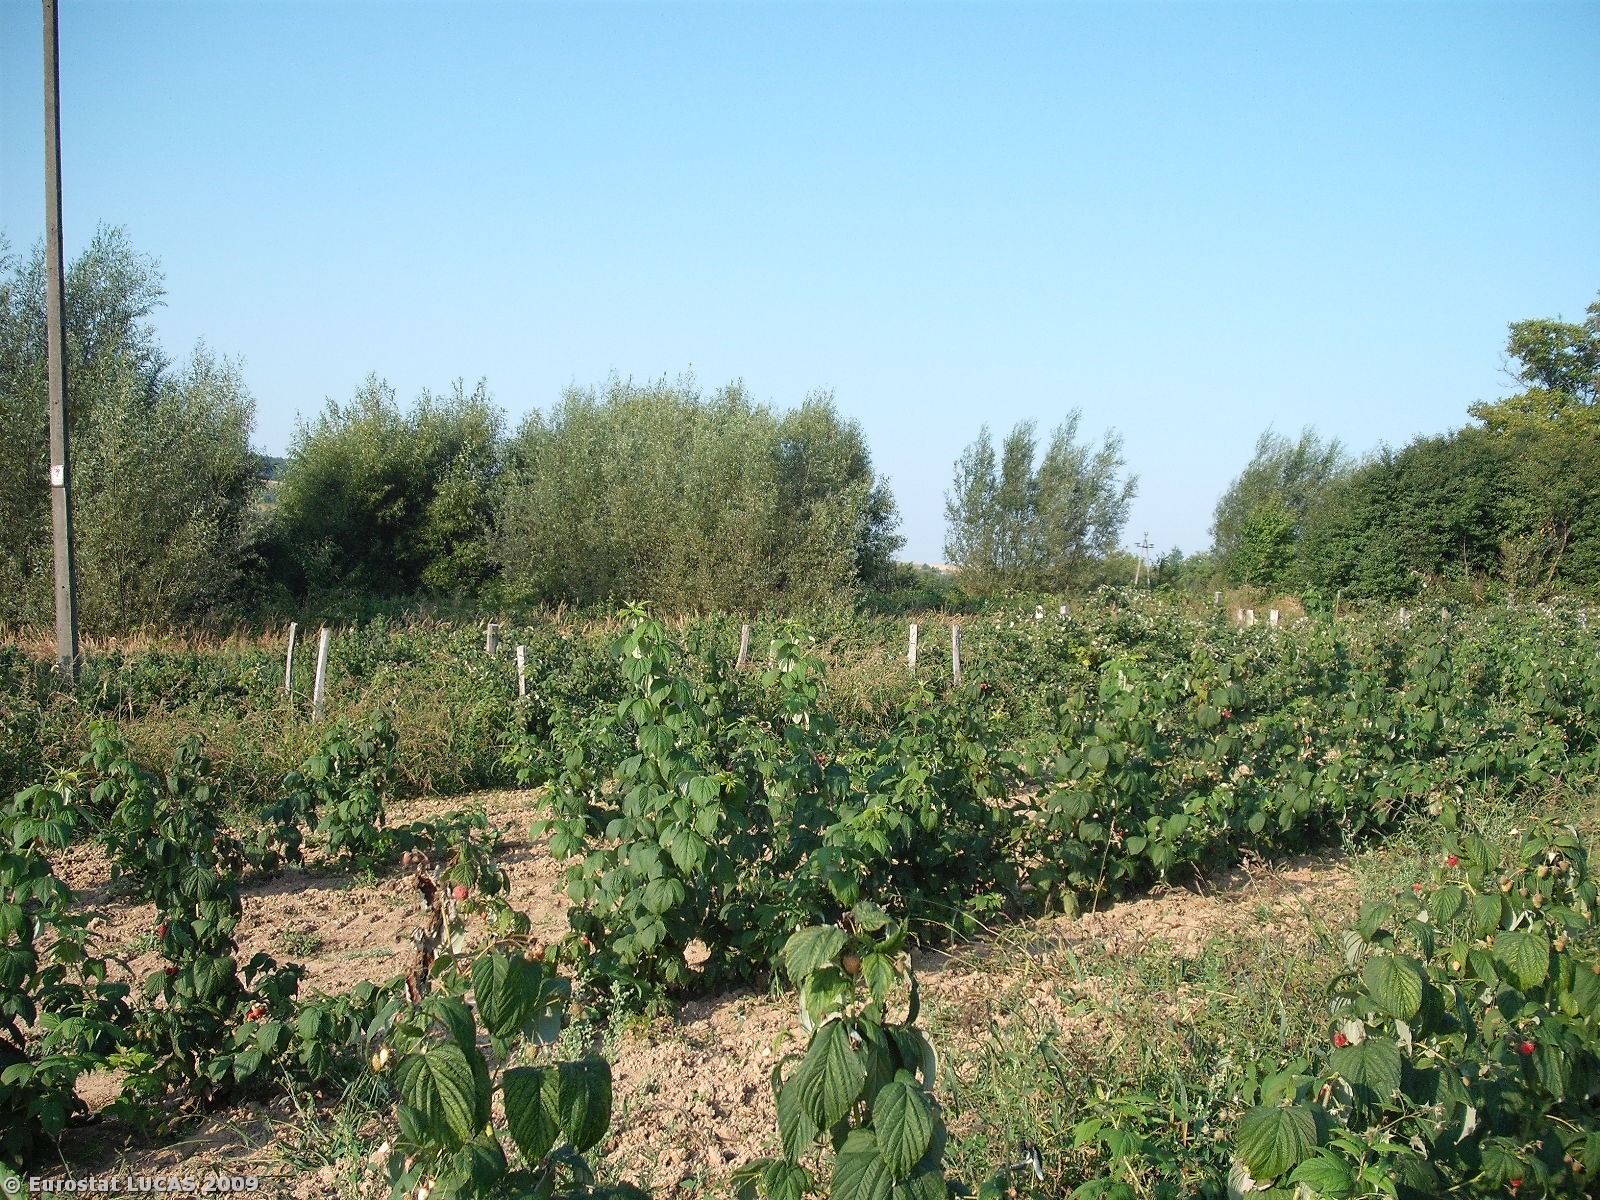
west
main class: Cropland
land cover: Other fruit trees and berries
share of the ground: 50 - 75 %
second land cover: Grassland with sparse tree/shrub cover
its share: > 75 %
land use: Agriculture (excluding fallow land and kitchen gardens)
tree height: < 5 m
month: August
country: PL
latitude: 49.9207
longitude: 22.4180
